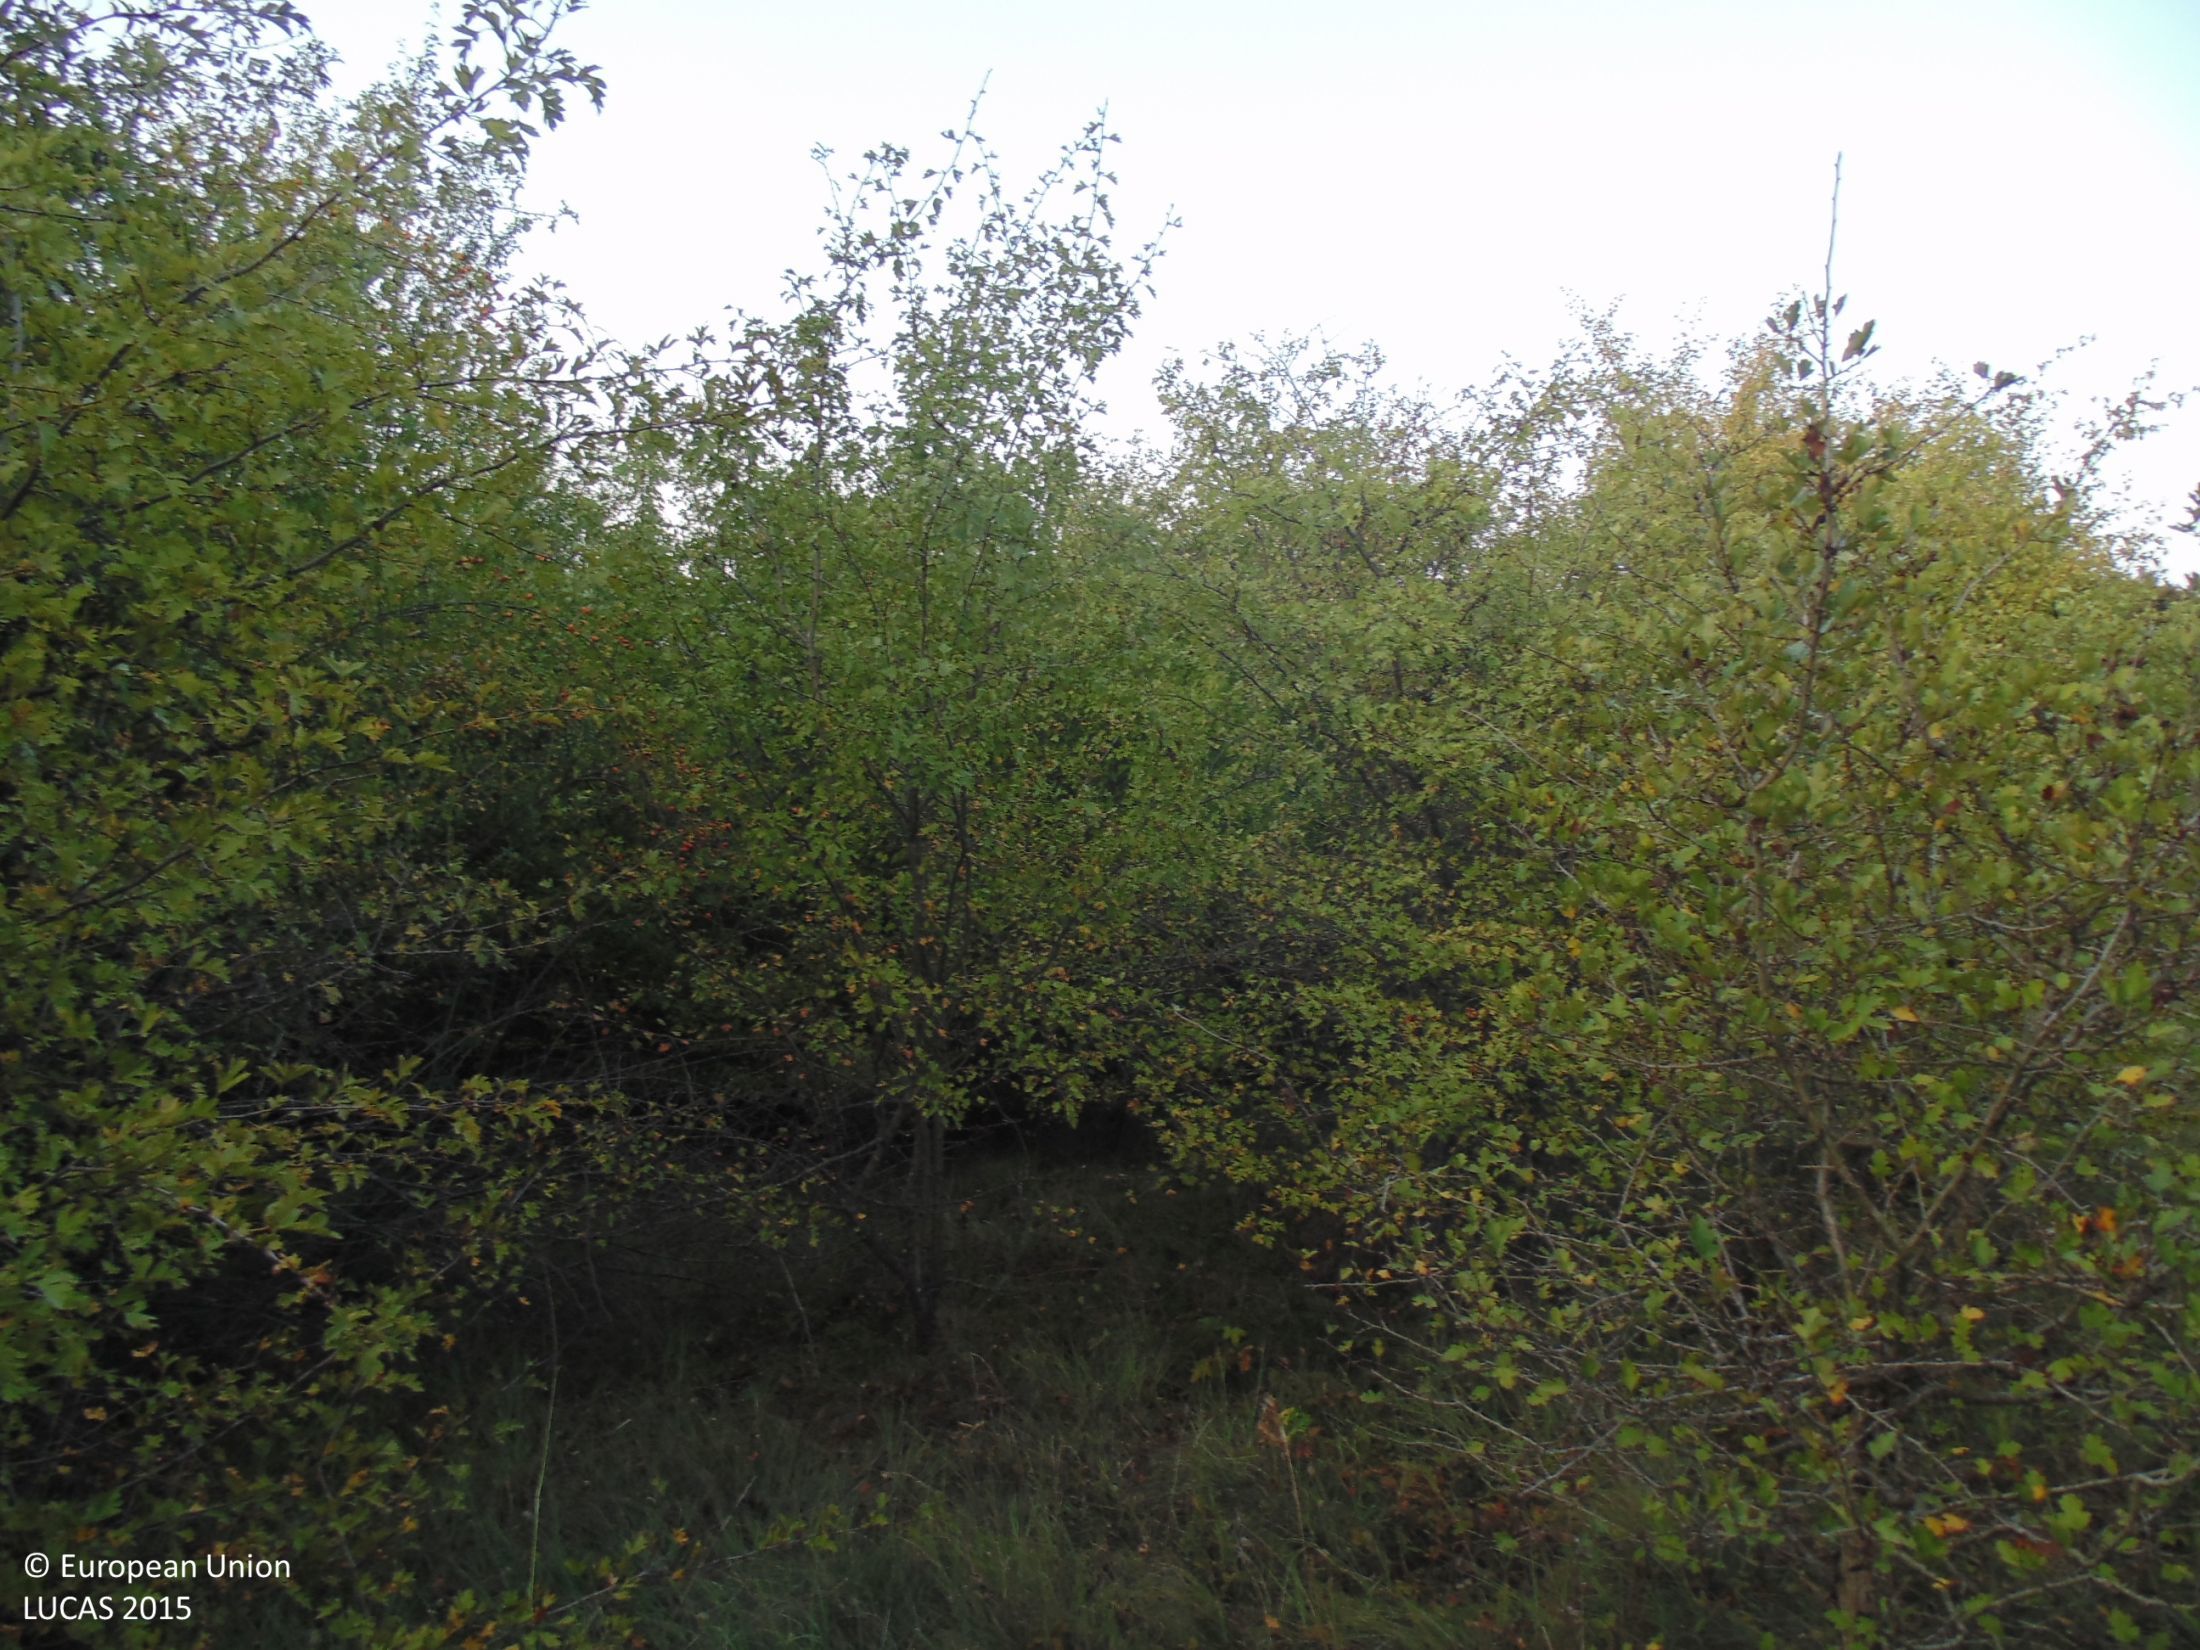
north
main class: Woodland
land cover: Broadleaved woodland
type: mesophytic deciduous forest
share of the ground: > 75 %
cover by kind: broadleaved forest trees 70 %, shrubs 20 %, herbaceous plants 10 %
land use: Forestry
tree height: < 5 m
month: August
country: BG
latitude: 43.8971
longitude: 27.2979
